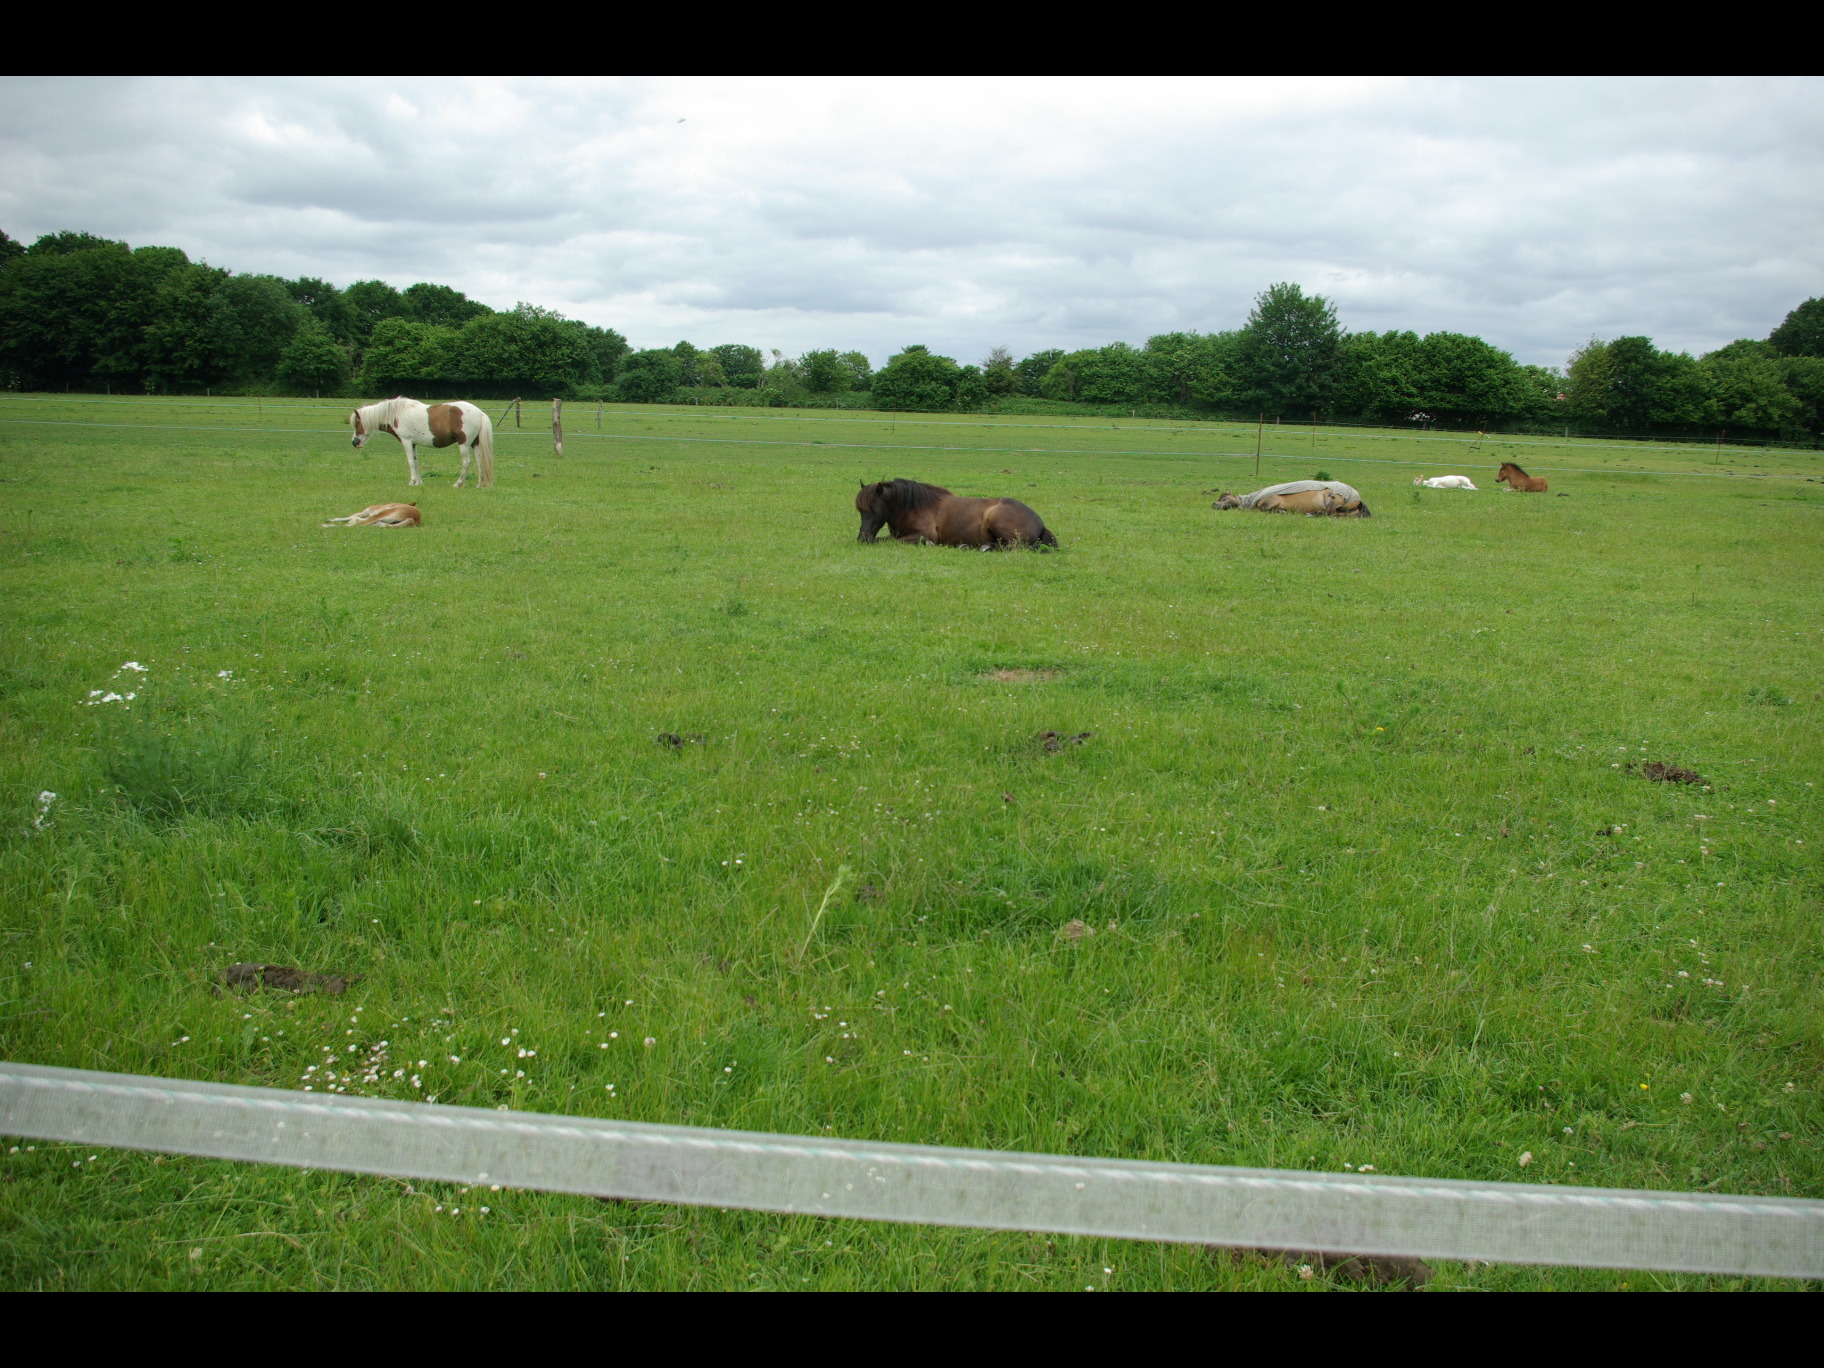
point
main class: Grassland
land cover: Grassland without tree/shrub cover
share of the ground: > 75 %
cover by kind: herbaceous plants 100 %
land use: Agriculture (excluding fallow land and kitchen gardens)
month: June
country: DE
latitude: 54.0489
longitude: 9.8931
